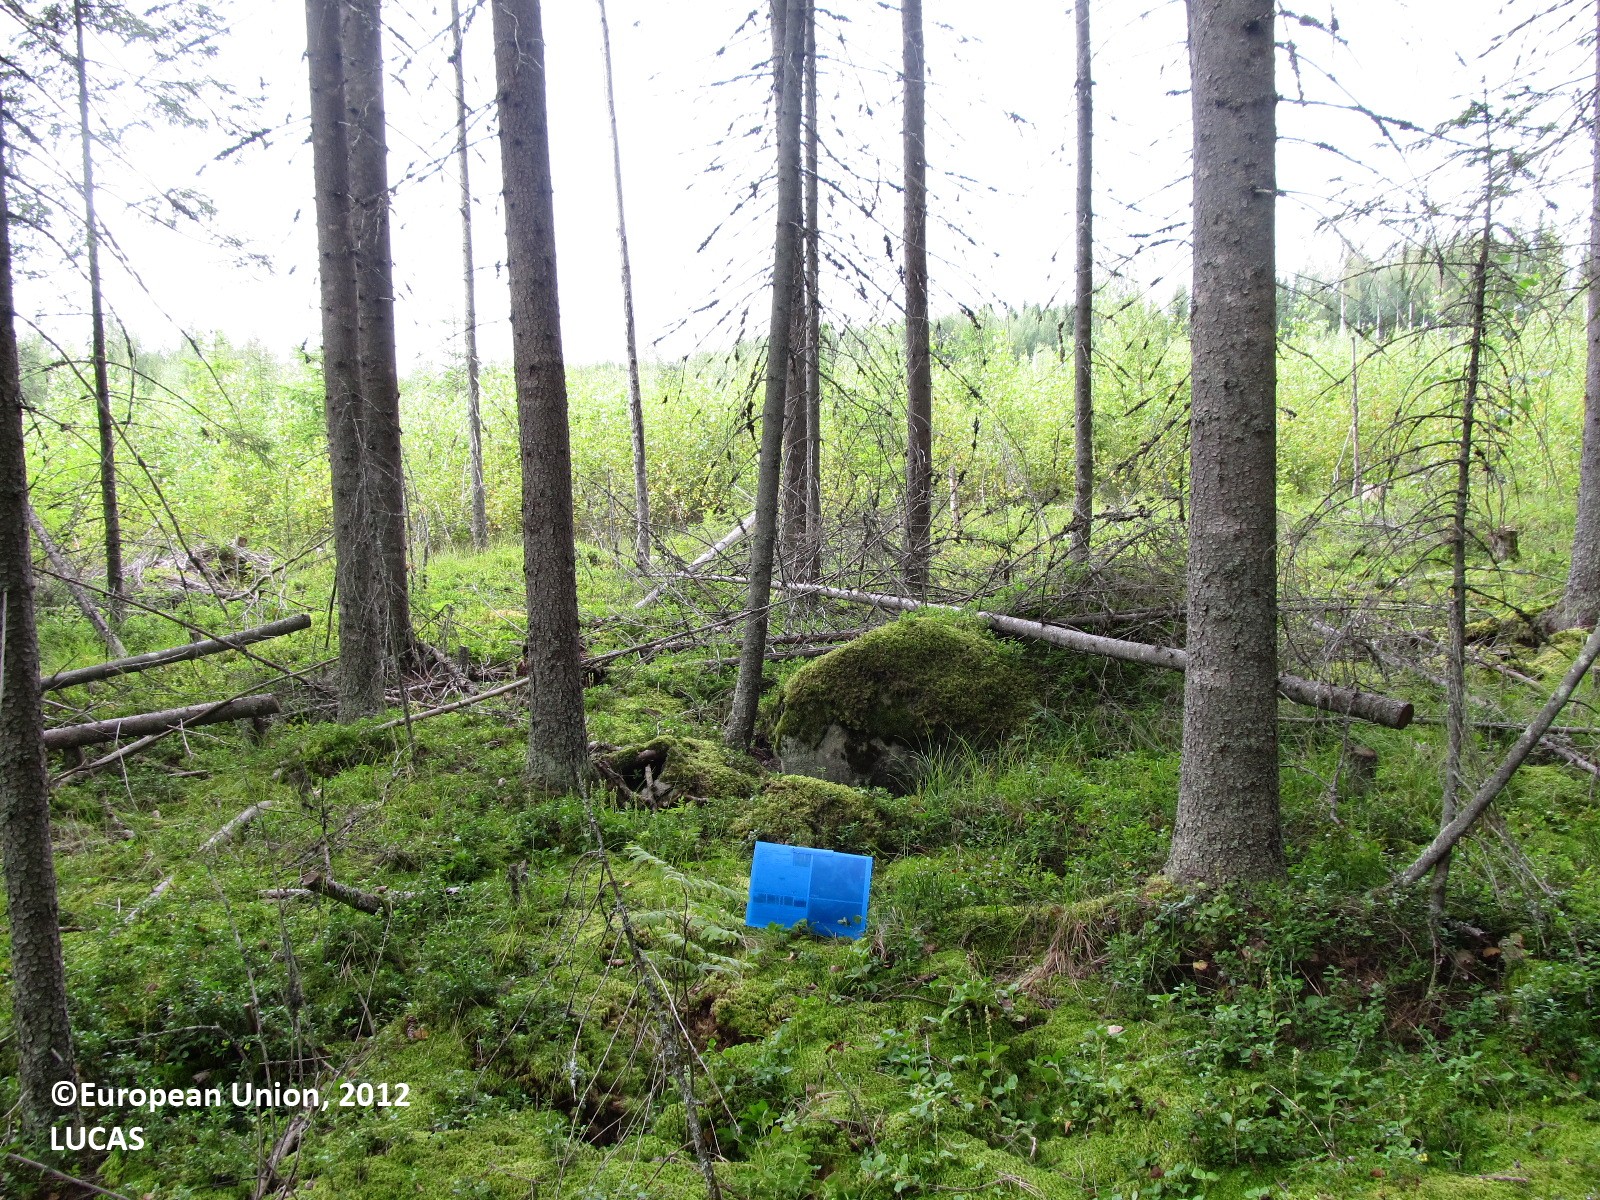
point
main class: Woodland
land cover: Spruce dominated coniferous woodland
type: boreal forest
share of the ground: 25 - 50 %
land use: Forestry
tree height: > 5 m
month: August
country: FI
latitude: 62.2954
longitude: 28.5809
